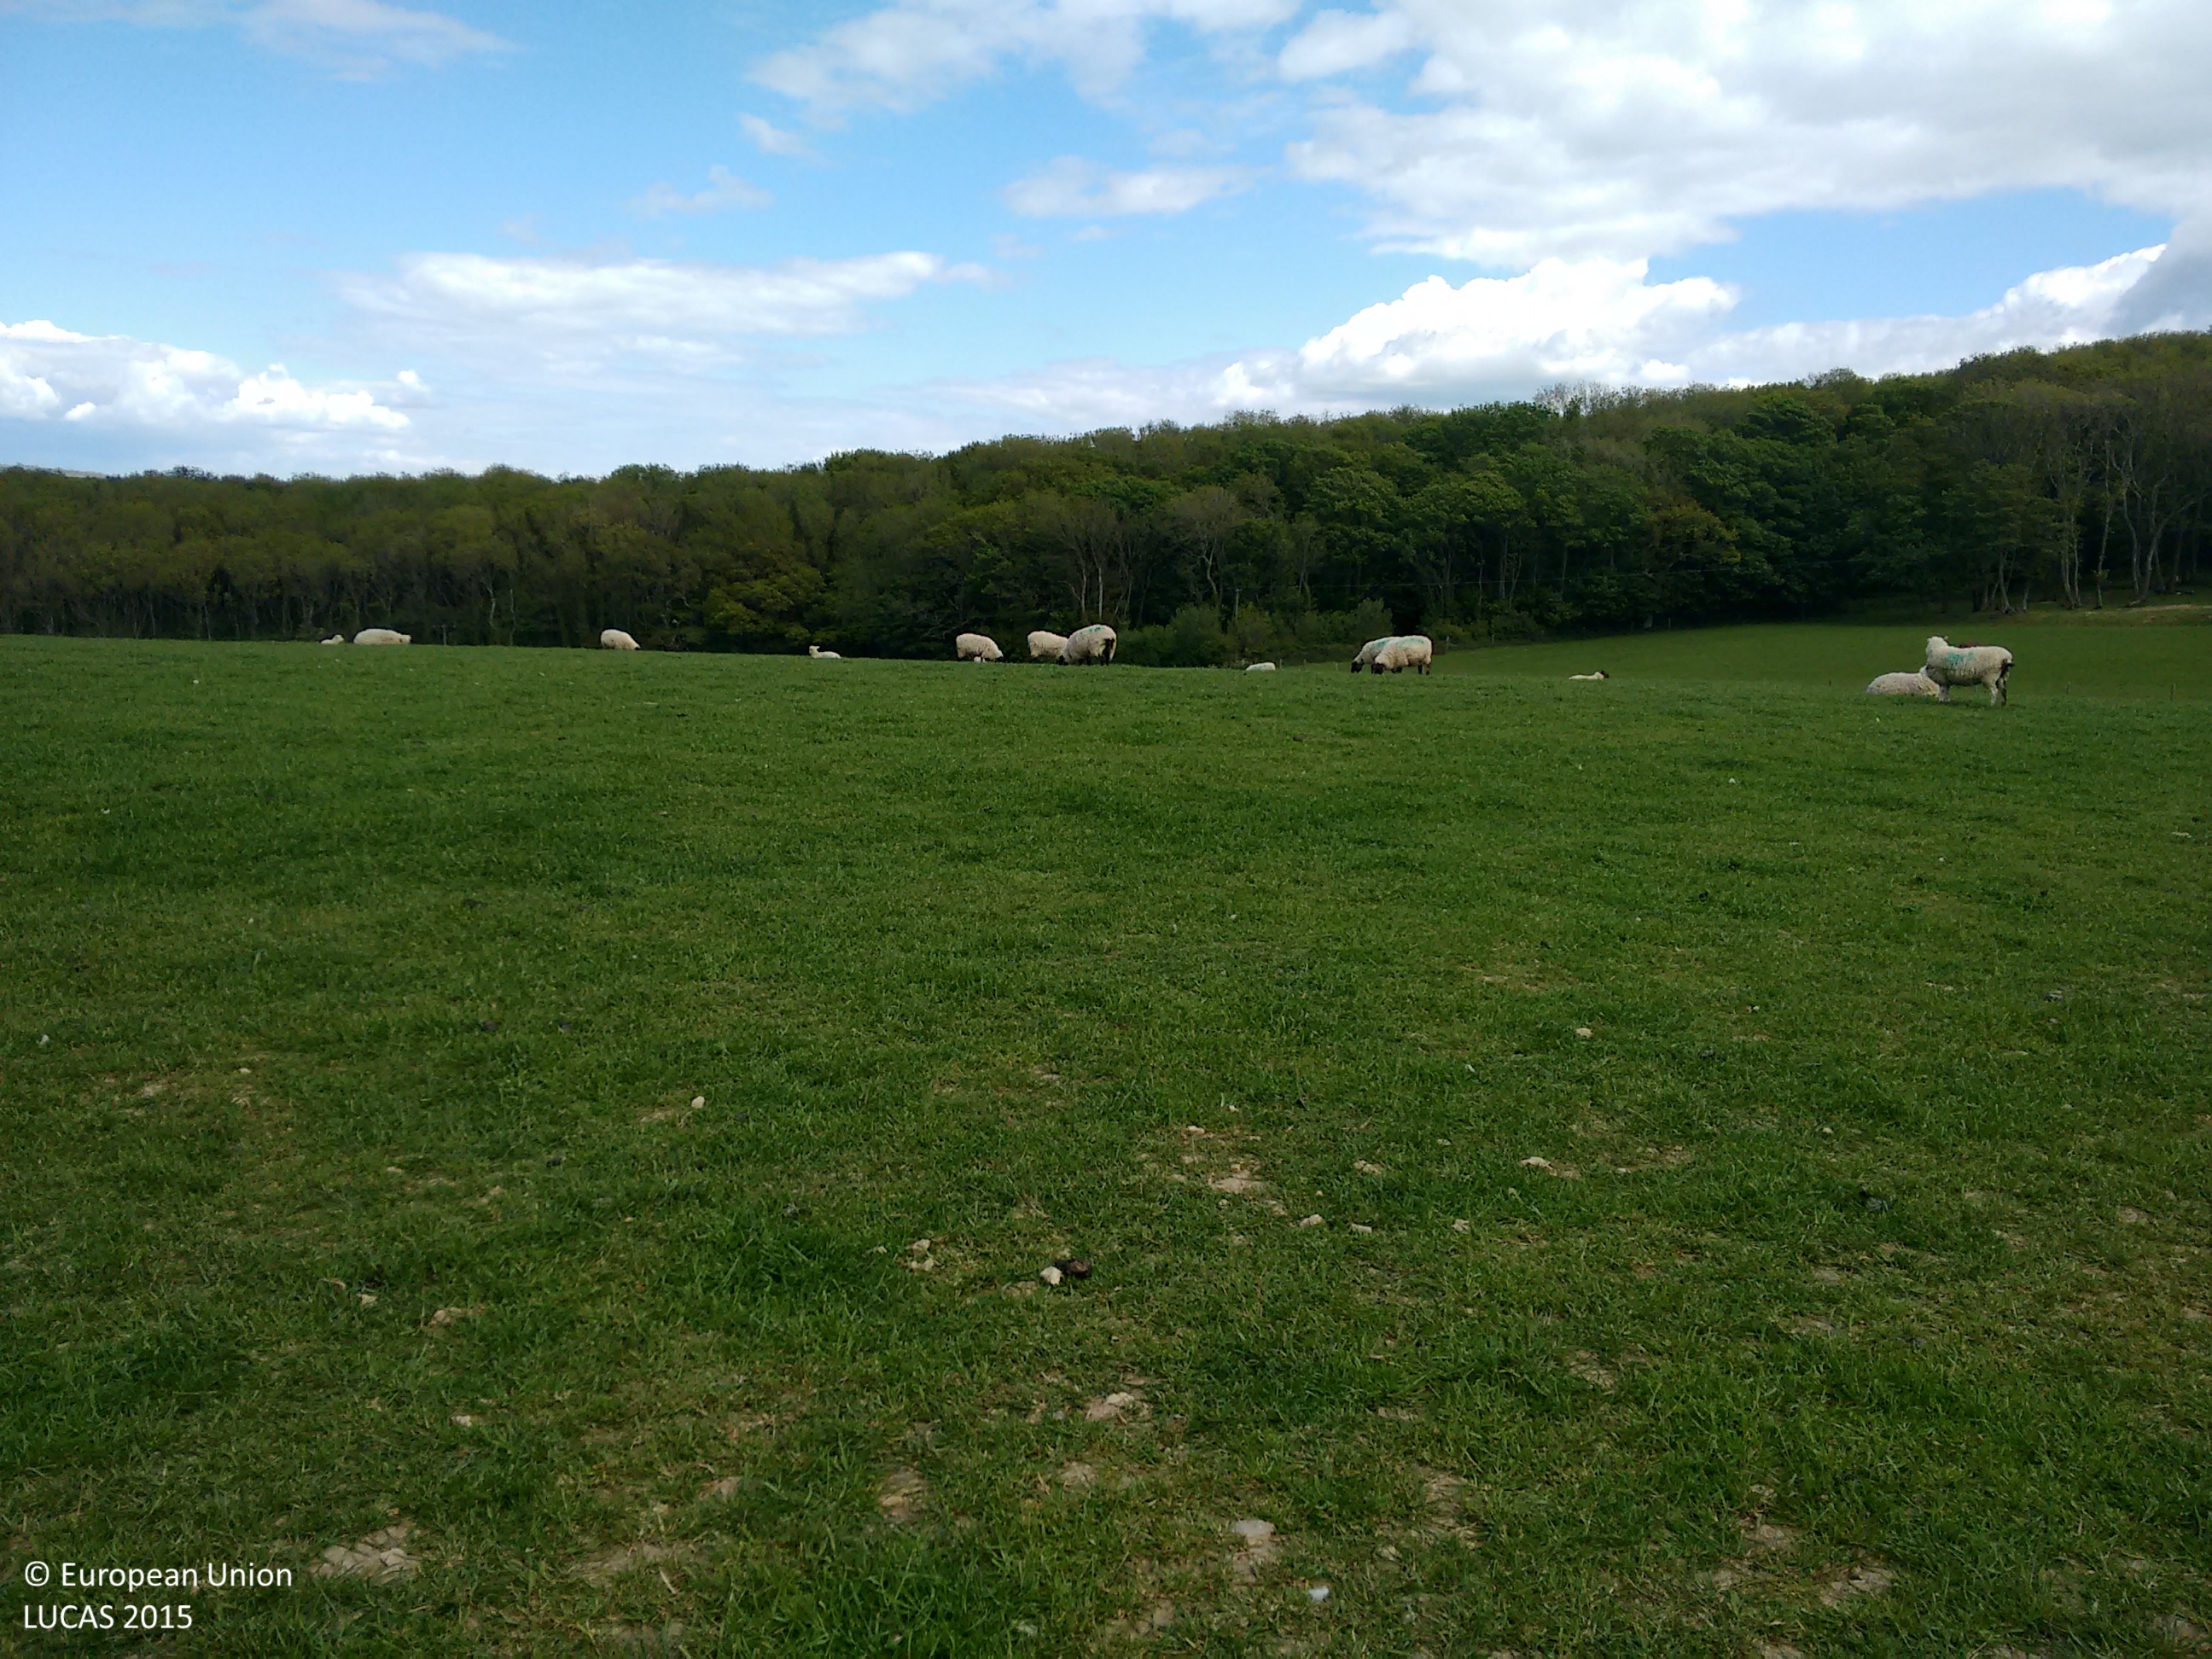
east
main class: Grassland
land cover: Grassland without tree/shrub cover
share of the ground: > 75 %
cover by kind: herbaceous plants 75 %, unconsolidated bare surface 25 %
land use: Agriculture (excluding fallow land and kitchen gardens)
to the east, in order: Managed hedges; Fences; Grassland without tree/shrub cover; Fences; Broadleaved woodland; Electric lines; Broadleaved woodland
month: May
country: GB
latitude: 50.6562
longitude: -1.2934
